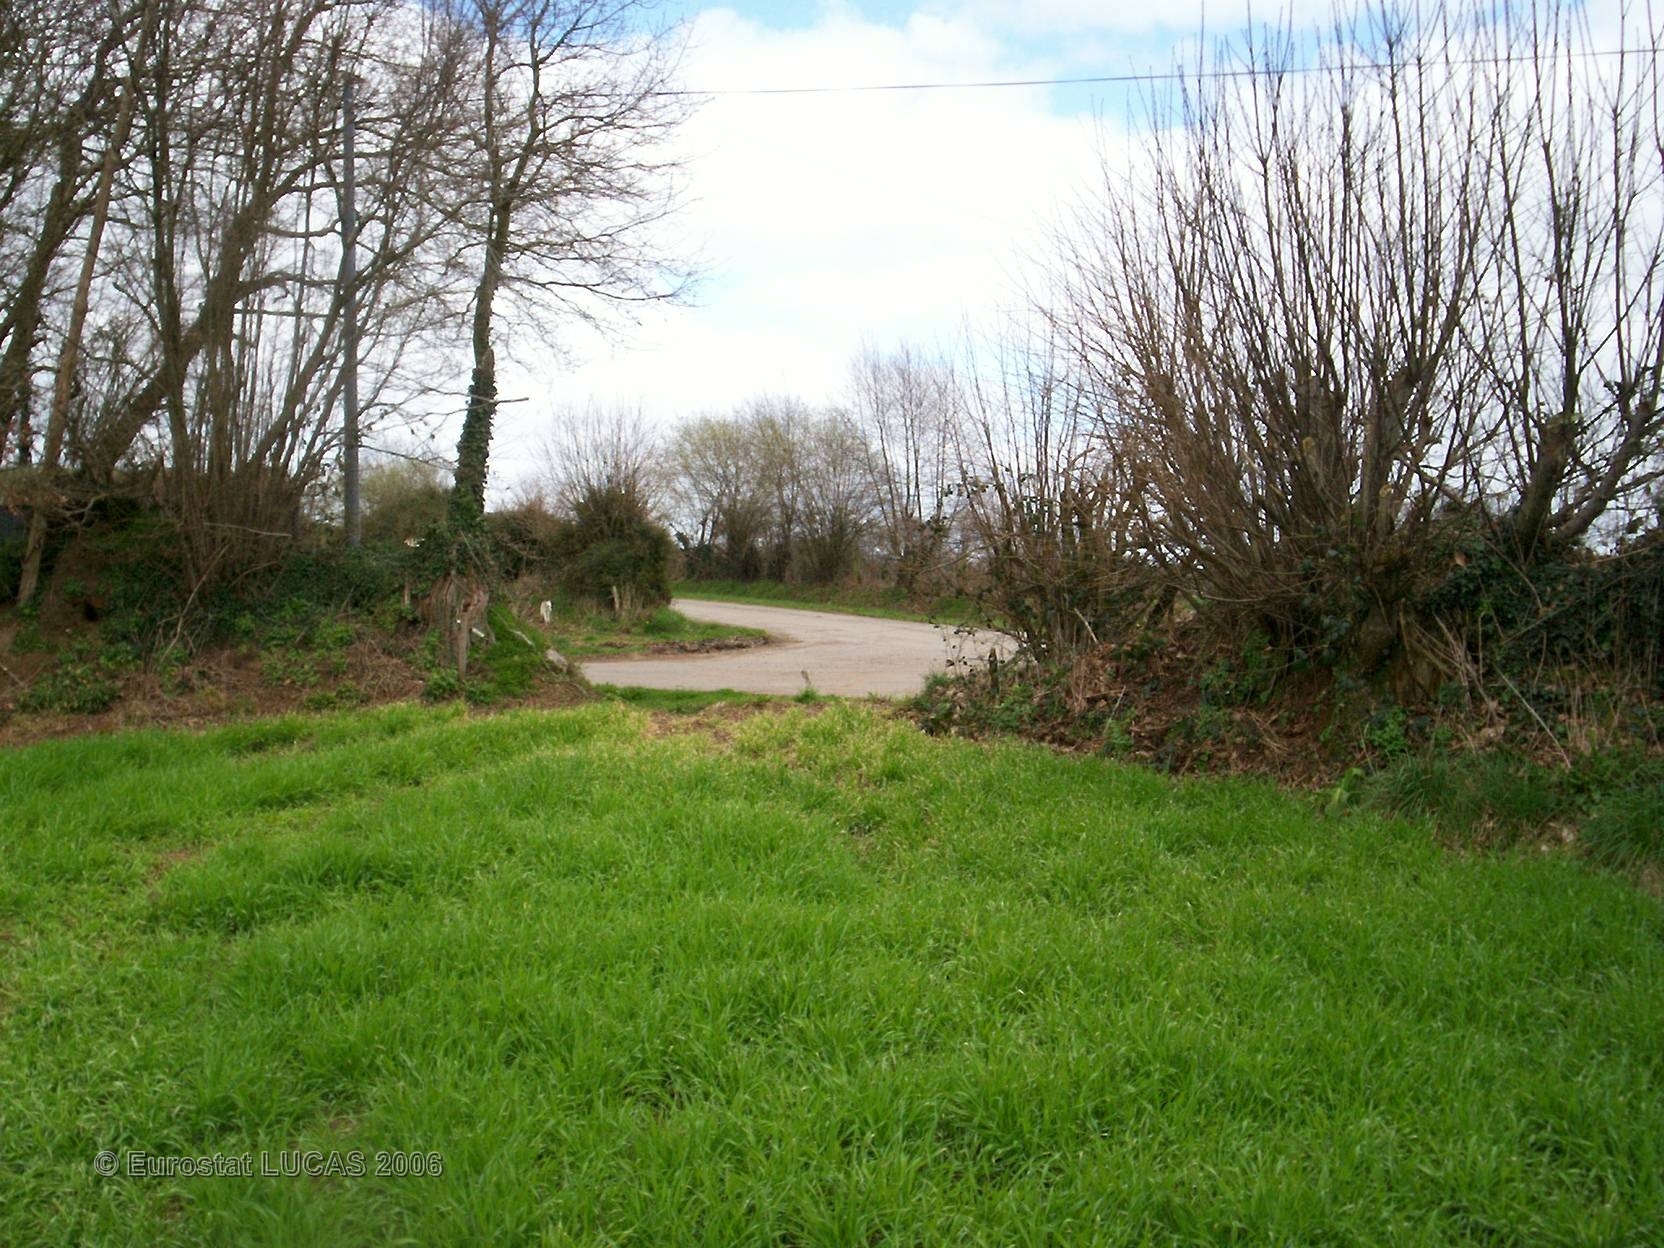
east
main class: Cropland
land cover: Barley
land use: Agriculture (excluding fallow land and kitchen gardens)
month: April
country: FR
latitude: 48.1053
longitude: -3.6030
